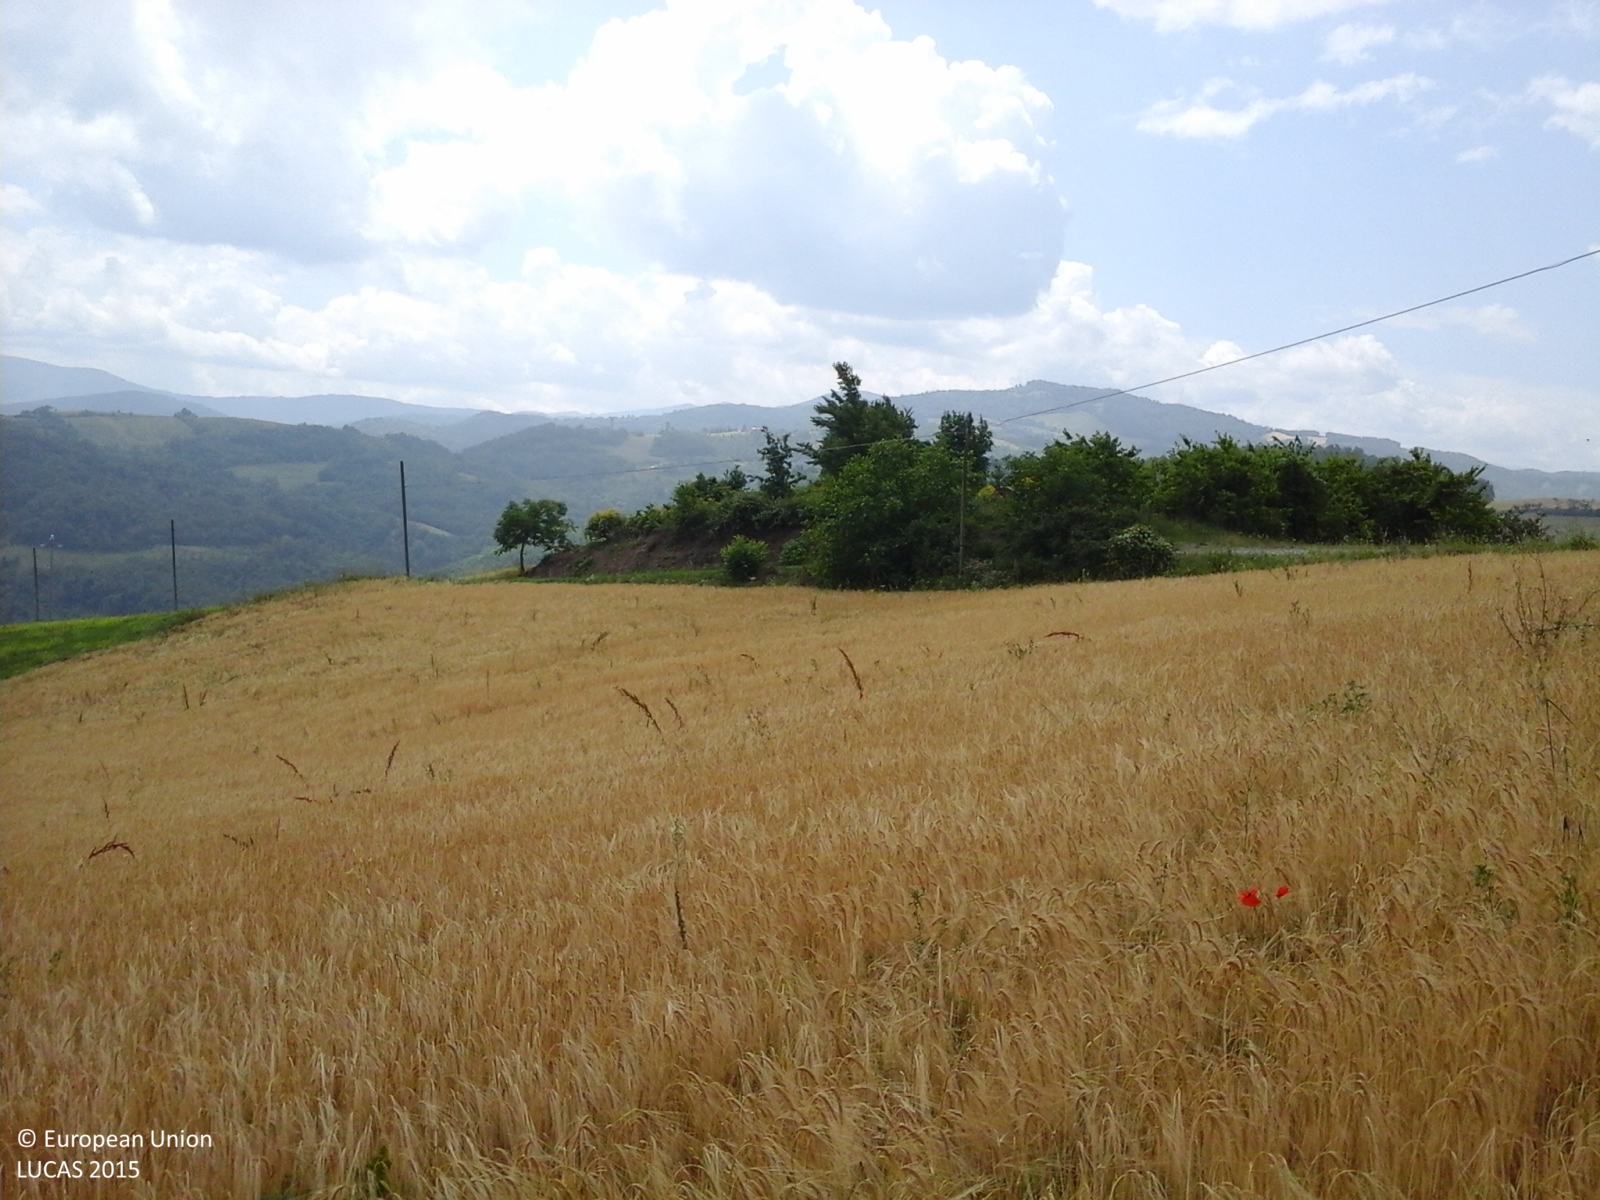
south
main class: Cropland
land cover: Barley
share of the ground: > 75 %
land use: Agriculture (excluding fallow land and kitchen gardens)
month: June
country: IT
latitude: 44.8369
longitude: 9.6592
